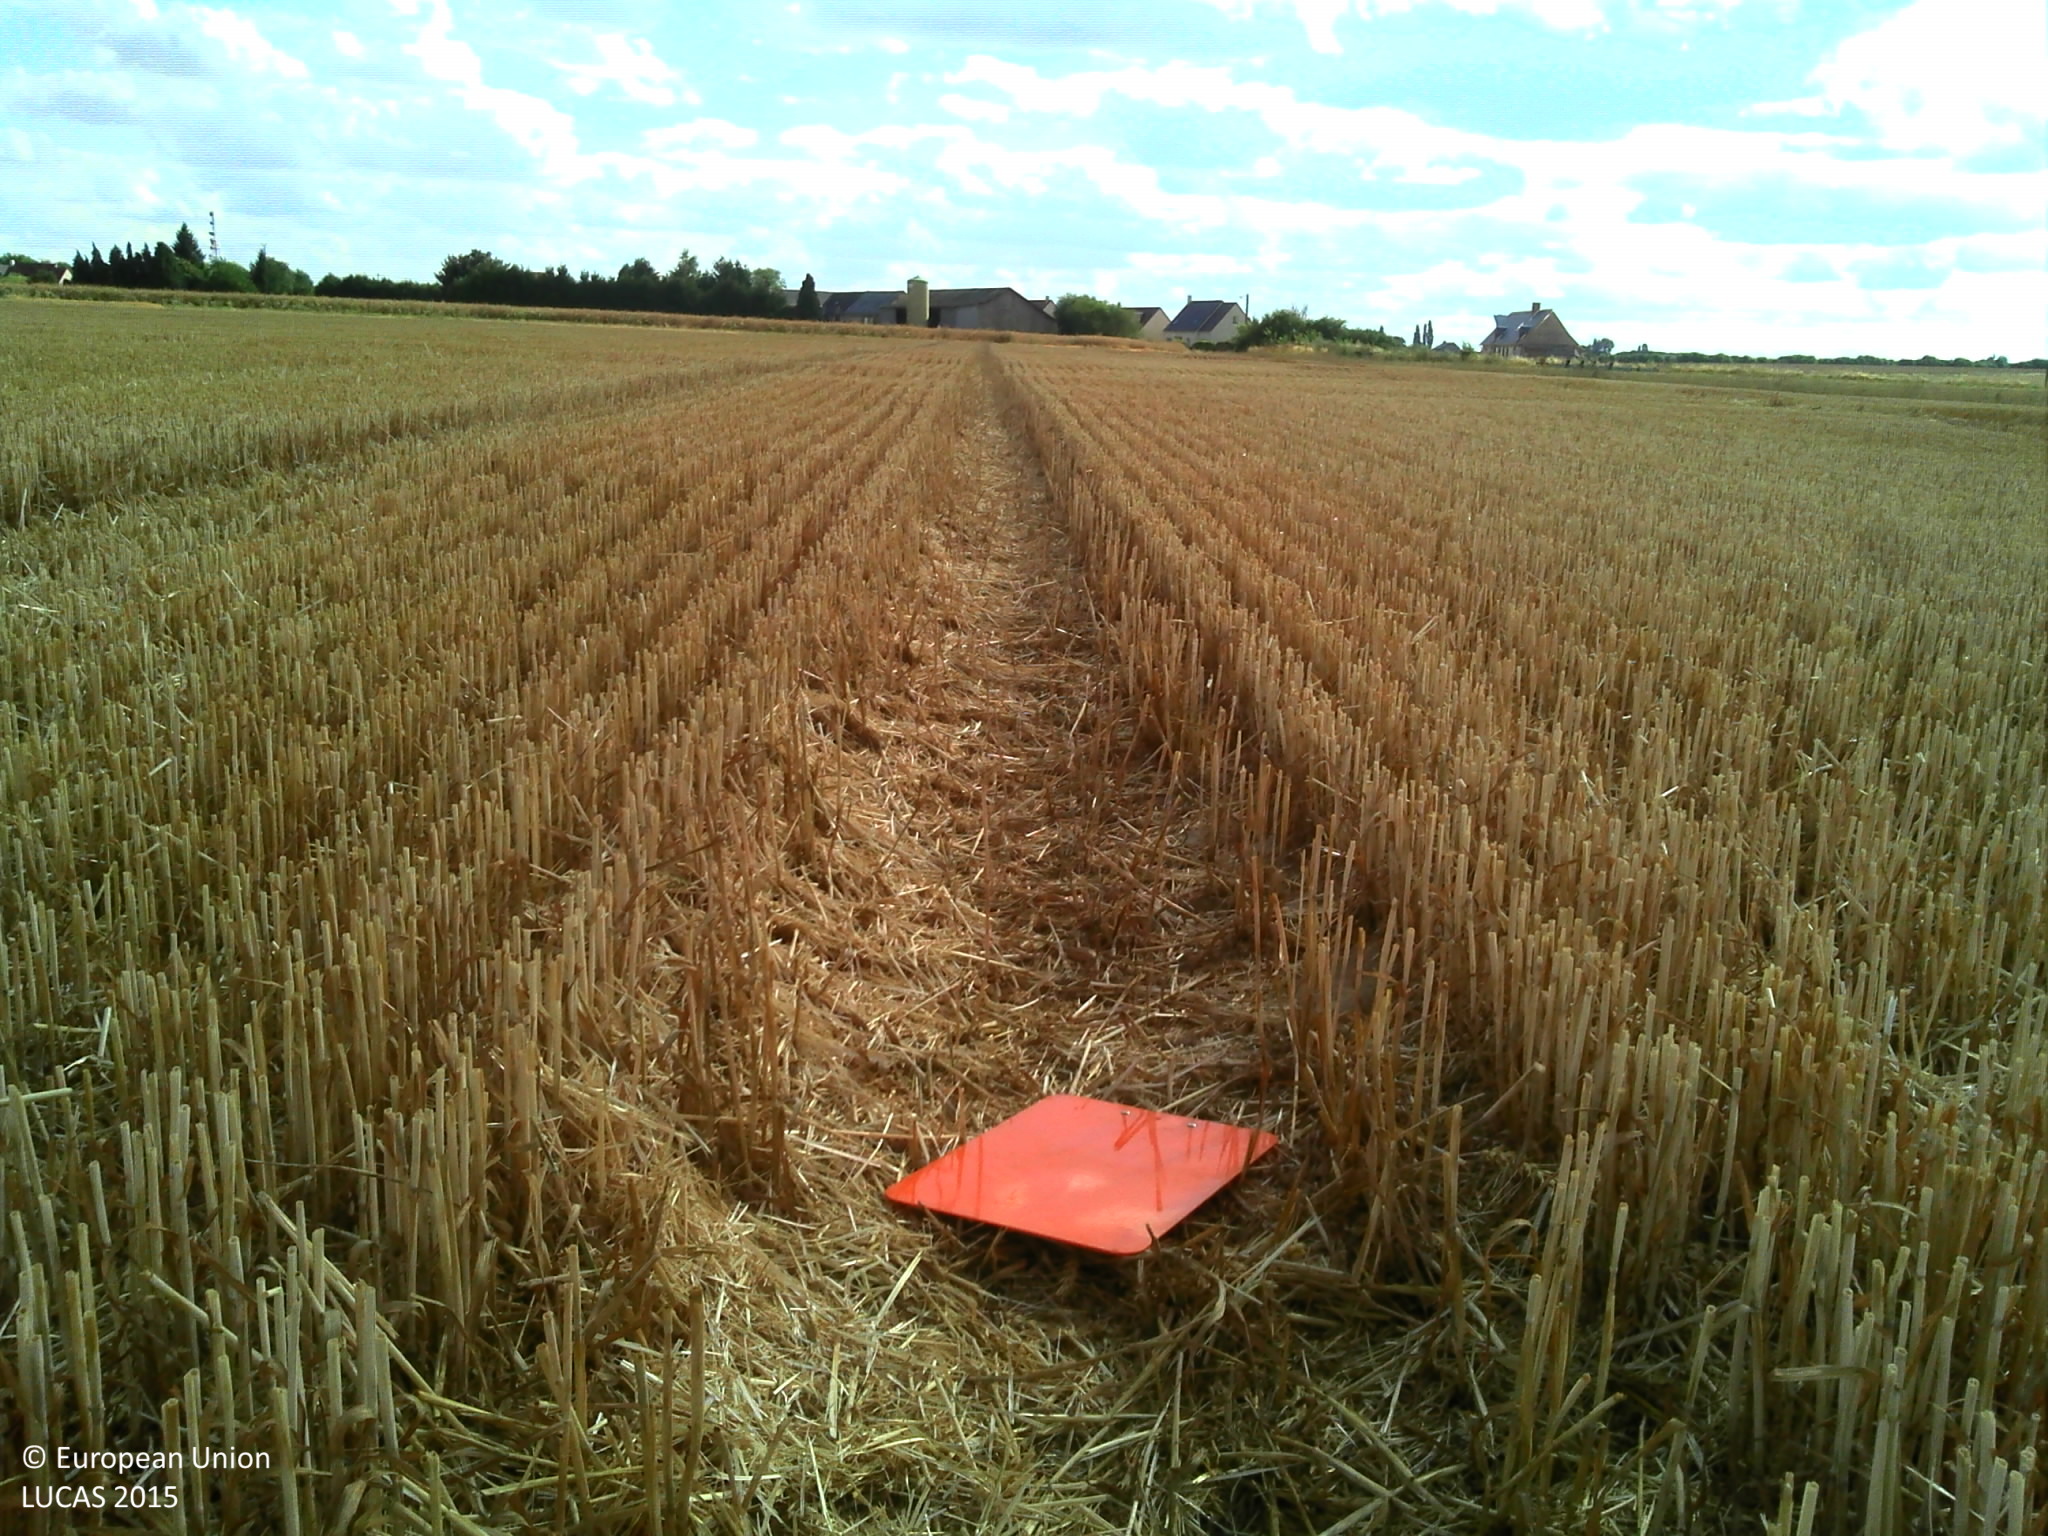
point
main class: Cropland
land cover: Common wheat
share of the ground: > 75 %
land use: Agriculture (excluding fallow land and kitchen gardens)
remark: Harvested field
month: July
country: FR
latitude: 48.5621
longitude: 1.2412
